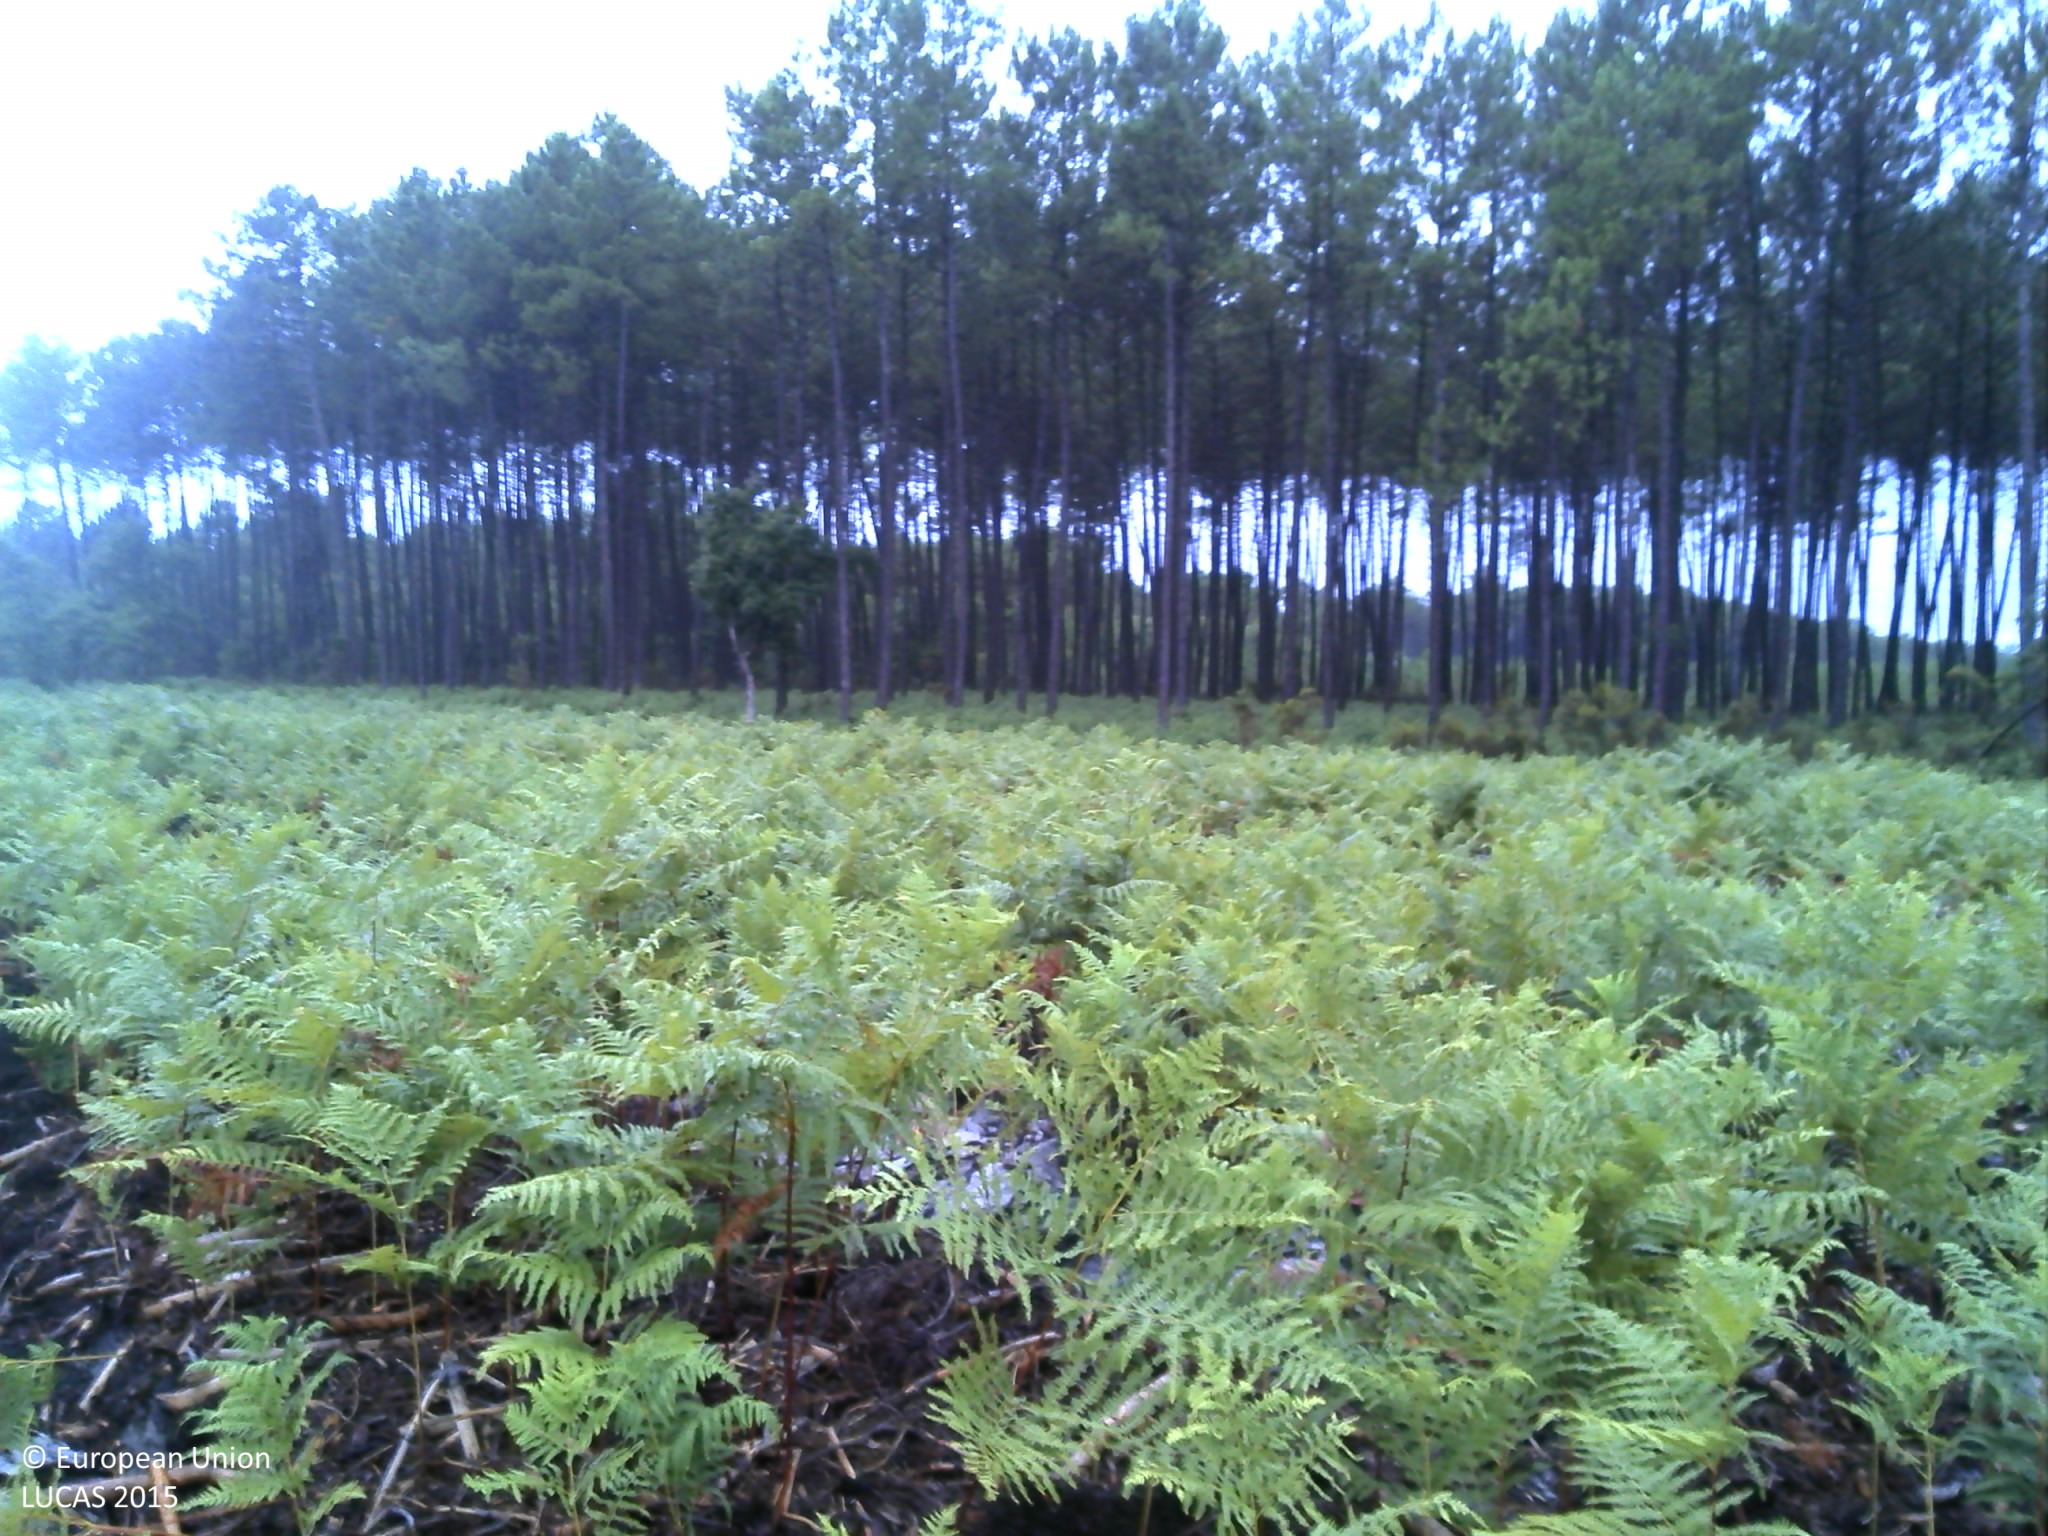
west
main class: Grassland
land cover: Spontaneously vegetated surfaces
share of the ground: > 75 %
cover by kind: herbaceous plants 90 %, shrubs 5 %, lichens and mosses 5 %
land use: Forestry
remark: Clear cut
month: August
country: FR
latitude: 44.5378
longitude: -0.9060
